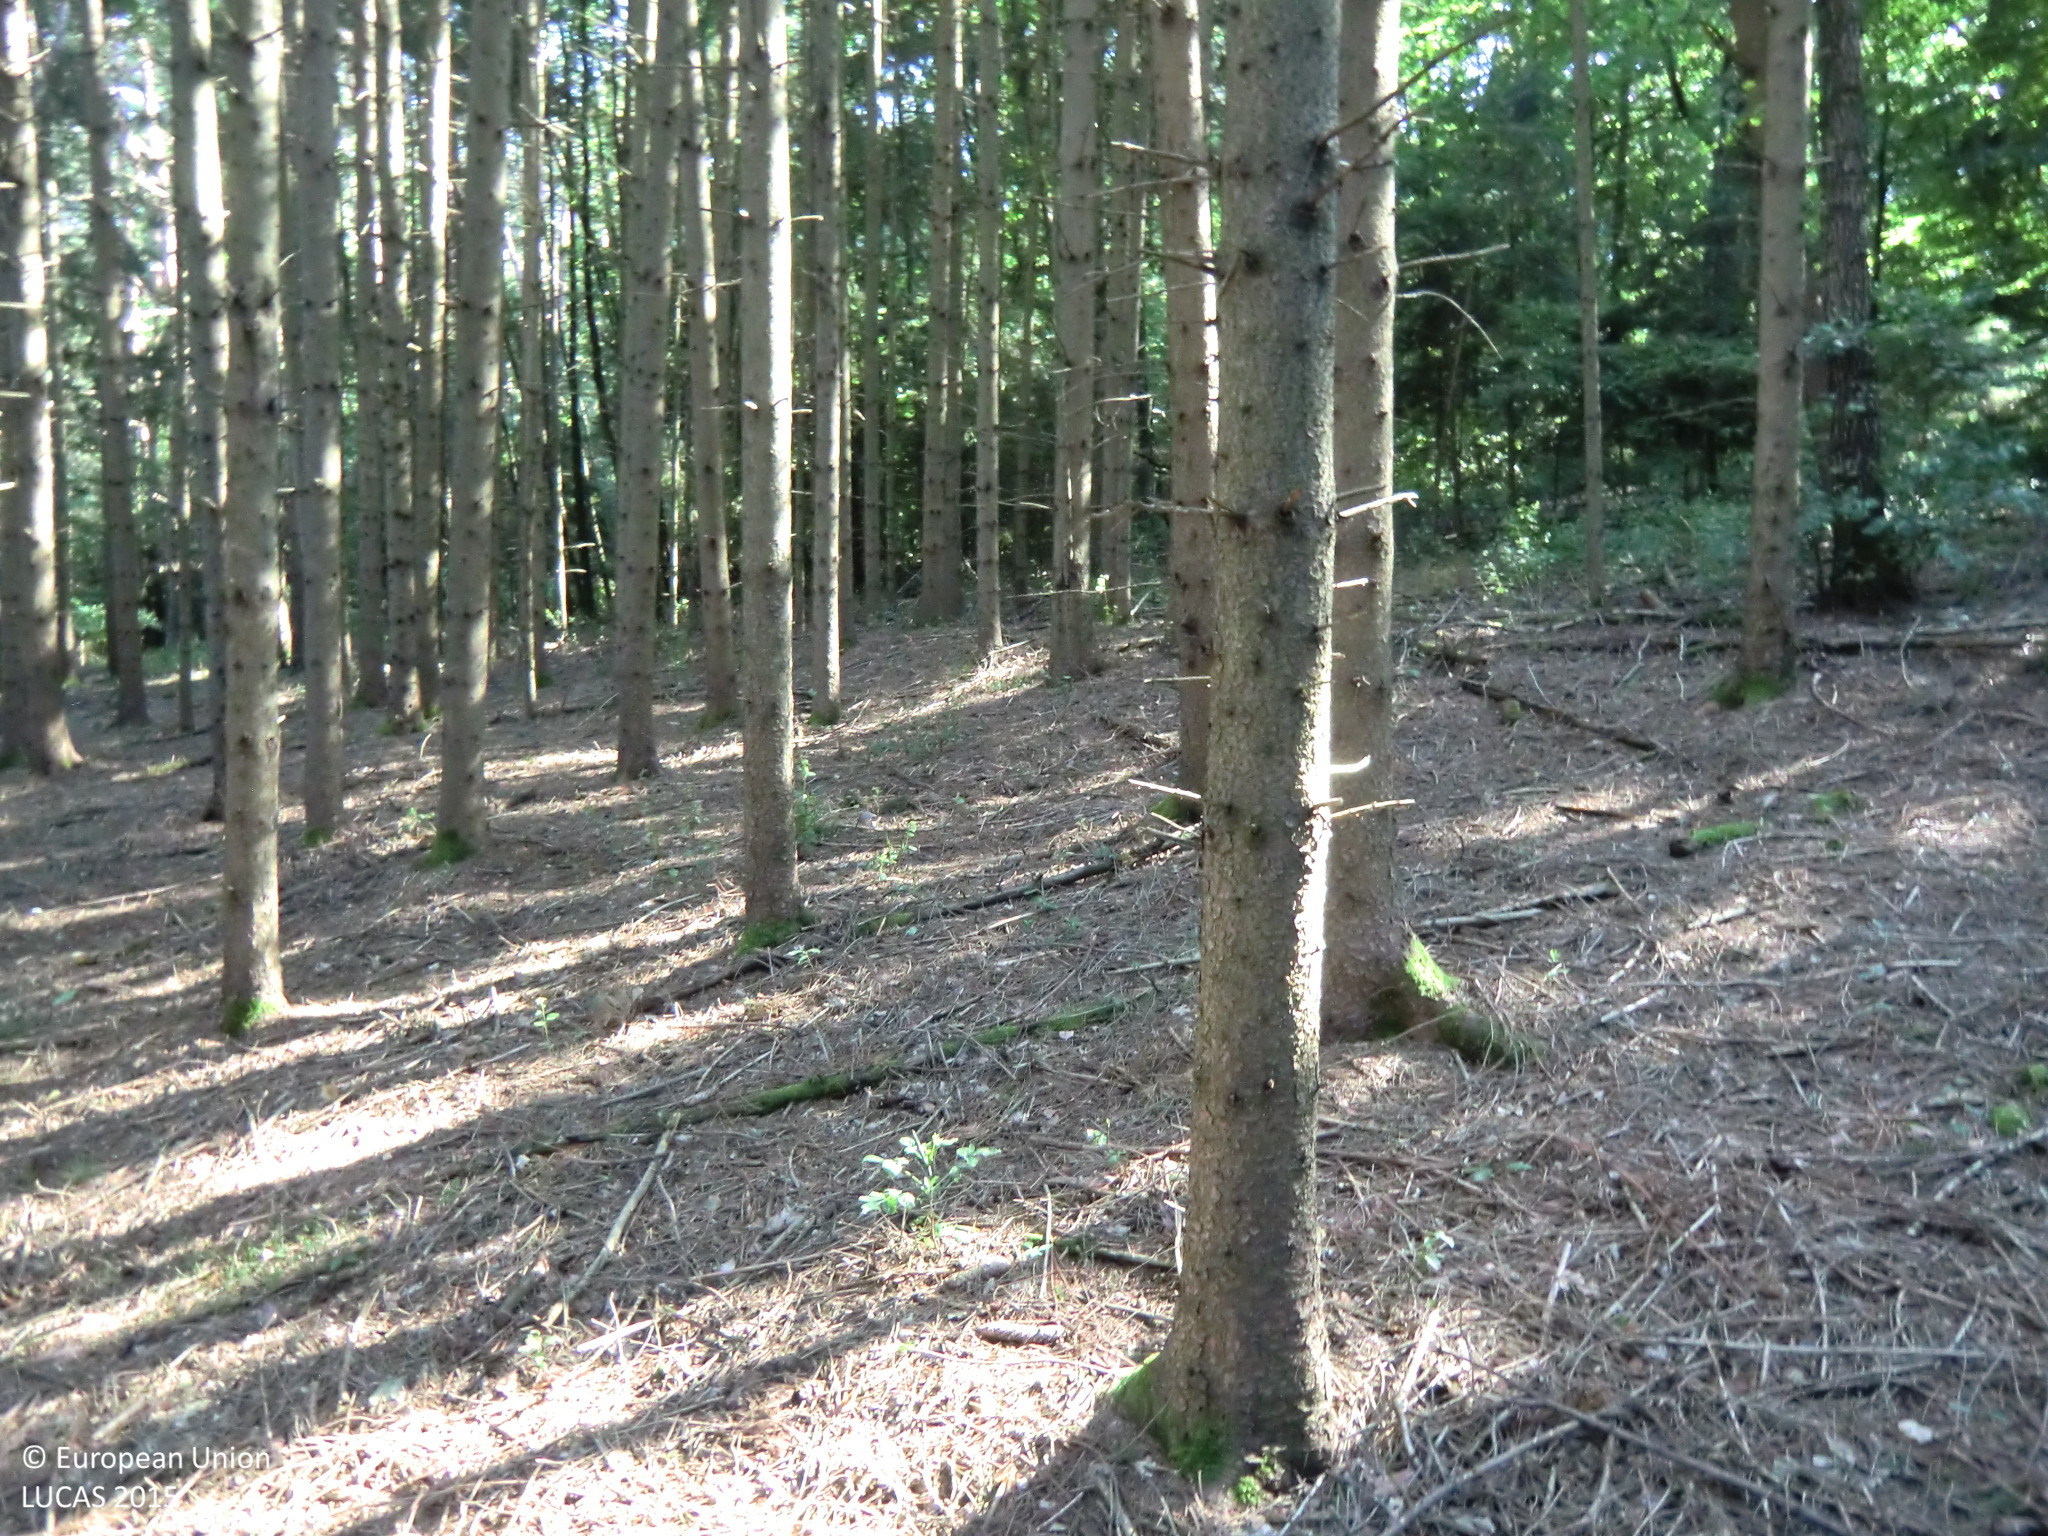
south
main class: Woodland
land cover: Spruce dominated coniferous woodland
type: hemiboreal forest and nemoral coniferous forest and mixed broadleaved-coniferous forest
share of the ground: > 75 %
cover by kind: coniferous forest trees 90 %, unconsolidated bare surface 10 %
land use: Forestry
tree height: > 5 m
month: July
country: AT
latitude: 47.0411
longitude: 16.1478
